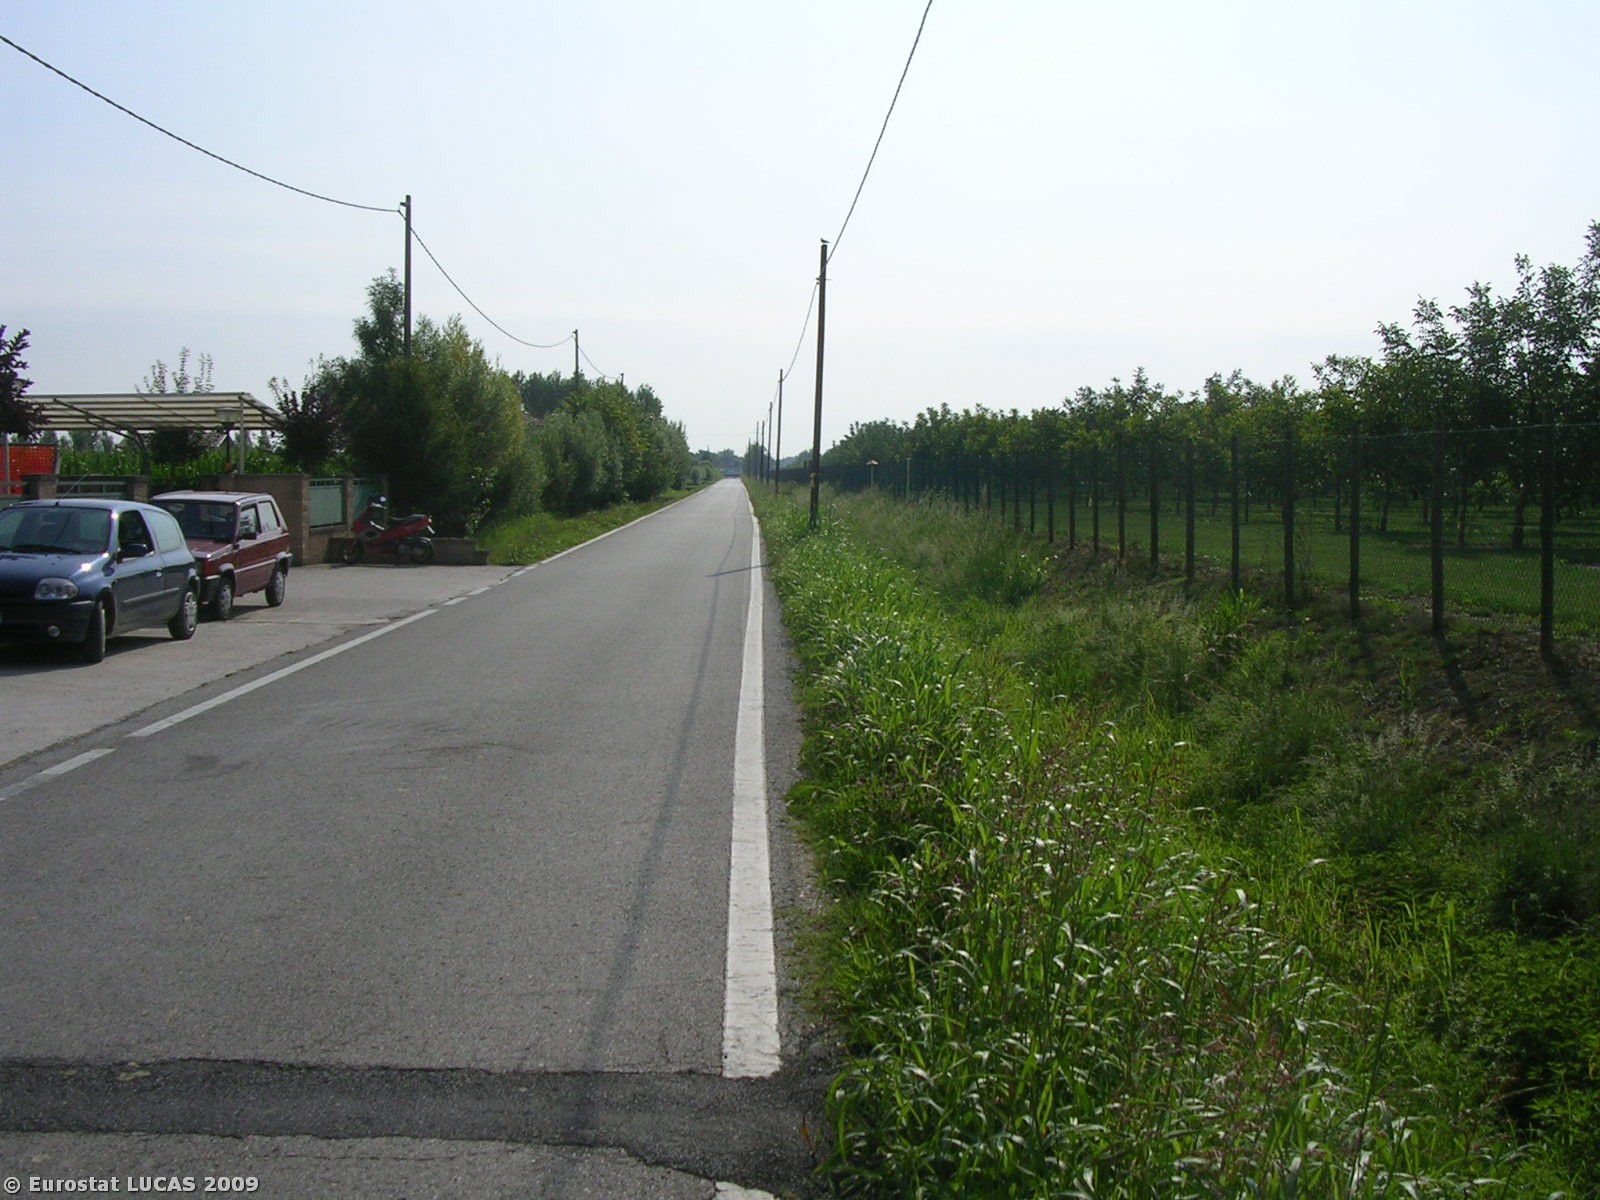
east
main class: Cropland
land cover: Nuts trees
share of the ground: 50 - 75 %
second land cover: Grassland with sparse tree/shrub cover
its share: 50 - 75 %
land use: Agriculture (excluding fallow land and kitchen gardens)
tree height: < 5 m
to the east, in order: Nuts trees; Grassland with sparse tree/shrub cover
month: July
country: IT
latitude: 45.5440
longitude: 11.7518
